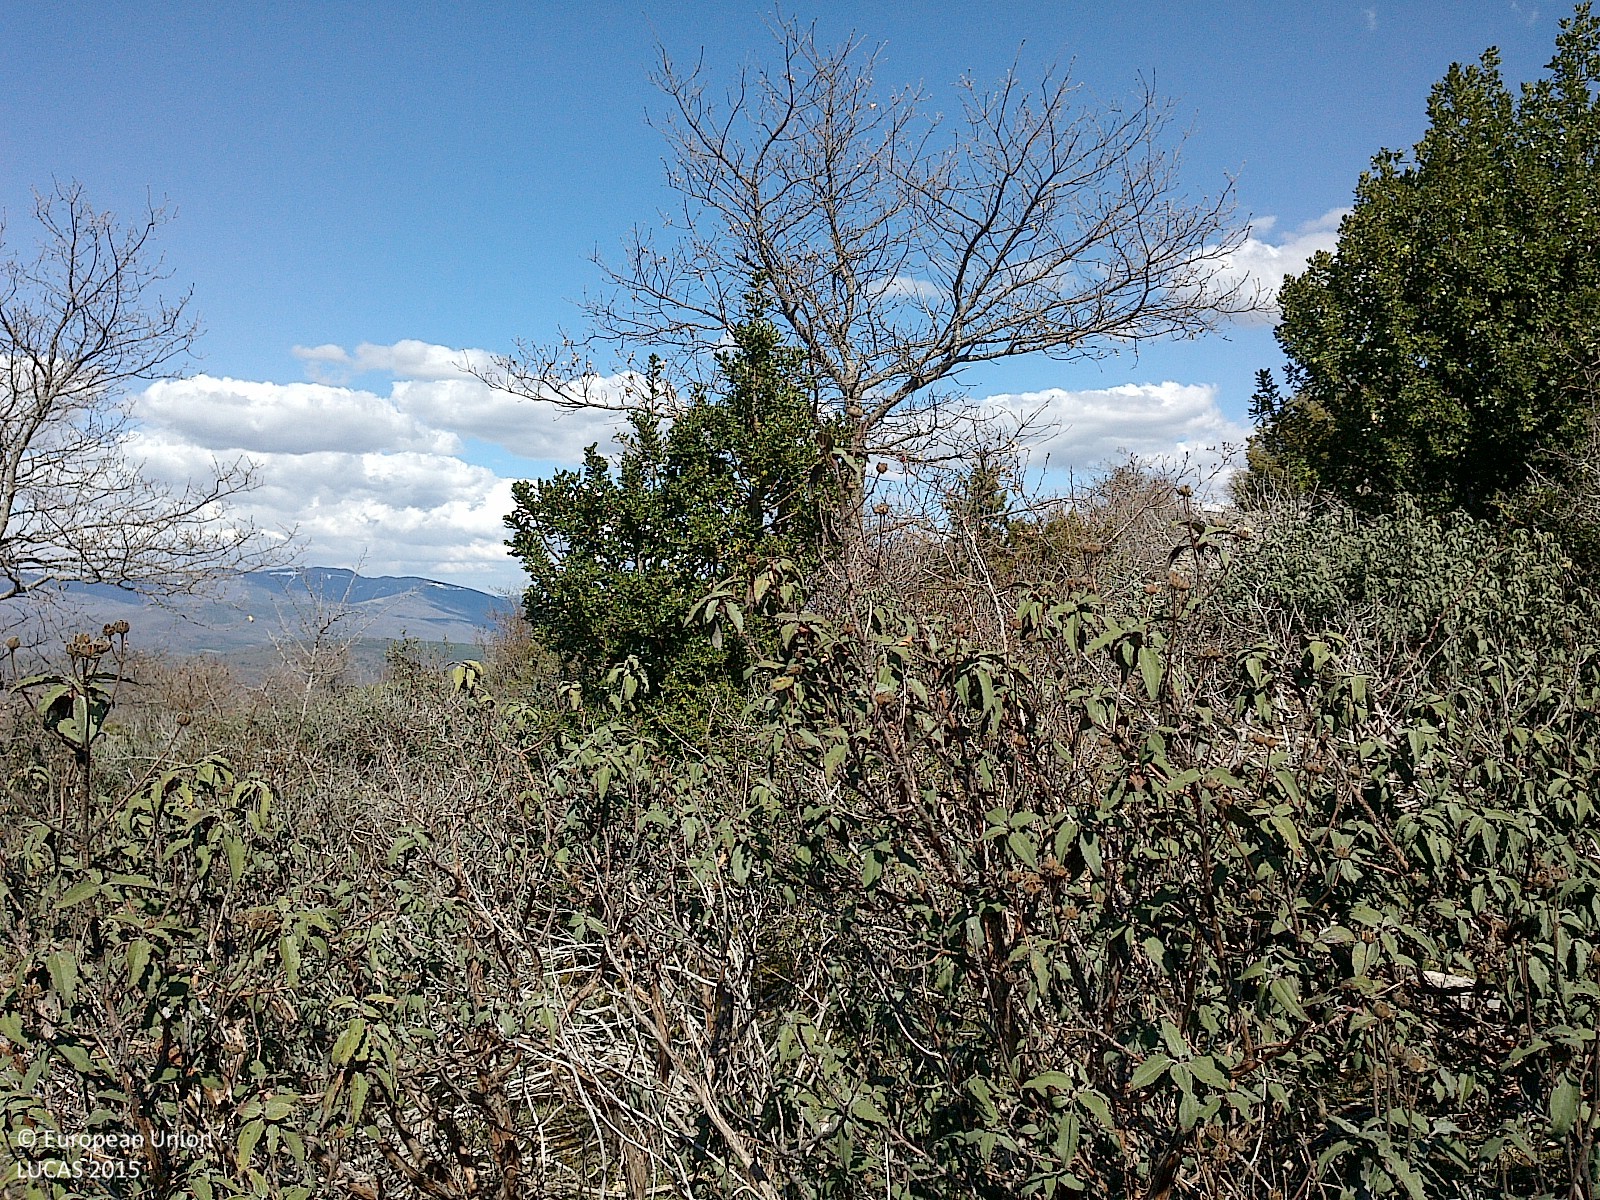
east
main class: Shrubland
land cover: Shrubland with sparse tree cover
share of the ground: > 75 %
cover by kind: shrubs 80 %, herbaceous plants 15 %, broadleaved forest trees 5 %
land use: Agriculture (excluding fallow land and kitchen gardens)
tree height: < 5 m
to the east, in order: Shrubland with sparse tree cover; Rock outcrops; Grassland with sparse tree/shrub cover; Tracks; Grassland with sparse tree/shrub cover; Fences; Shrubland with sparse tree cover
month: April
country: ES
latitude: 42.0943
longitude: -3.2176
